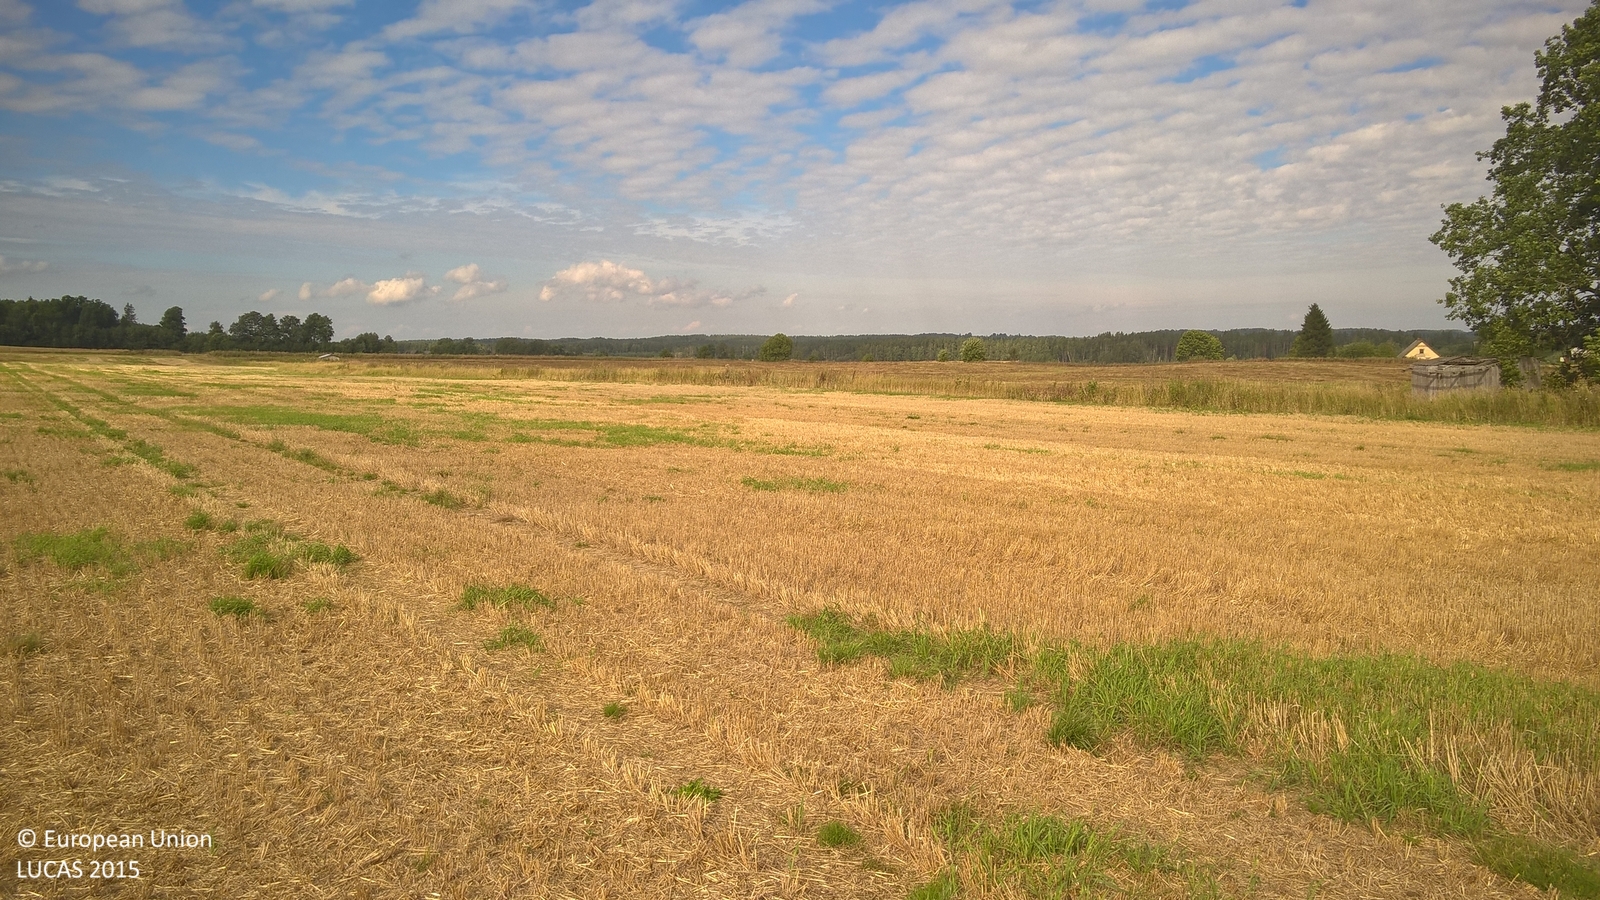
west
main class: Cropland
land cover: Barley
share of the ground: < 10 %
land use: Agriculture (excluding fallow land and kitchen gardens)
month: September
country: LV
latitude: 57.3326
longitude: 25.4809
